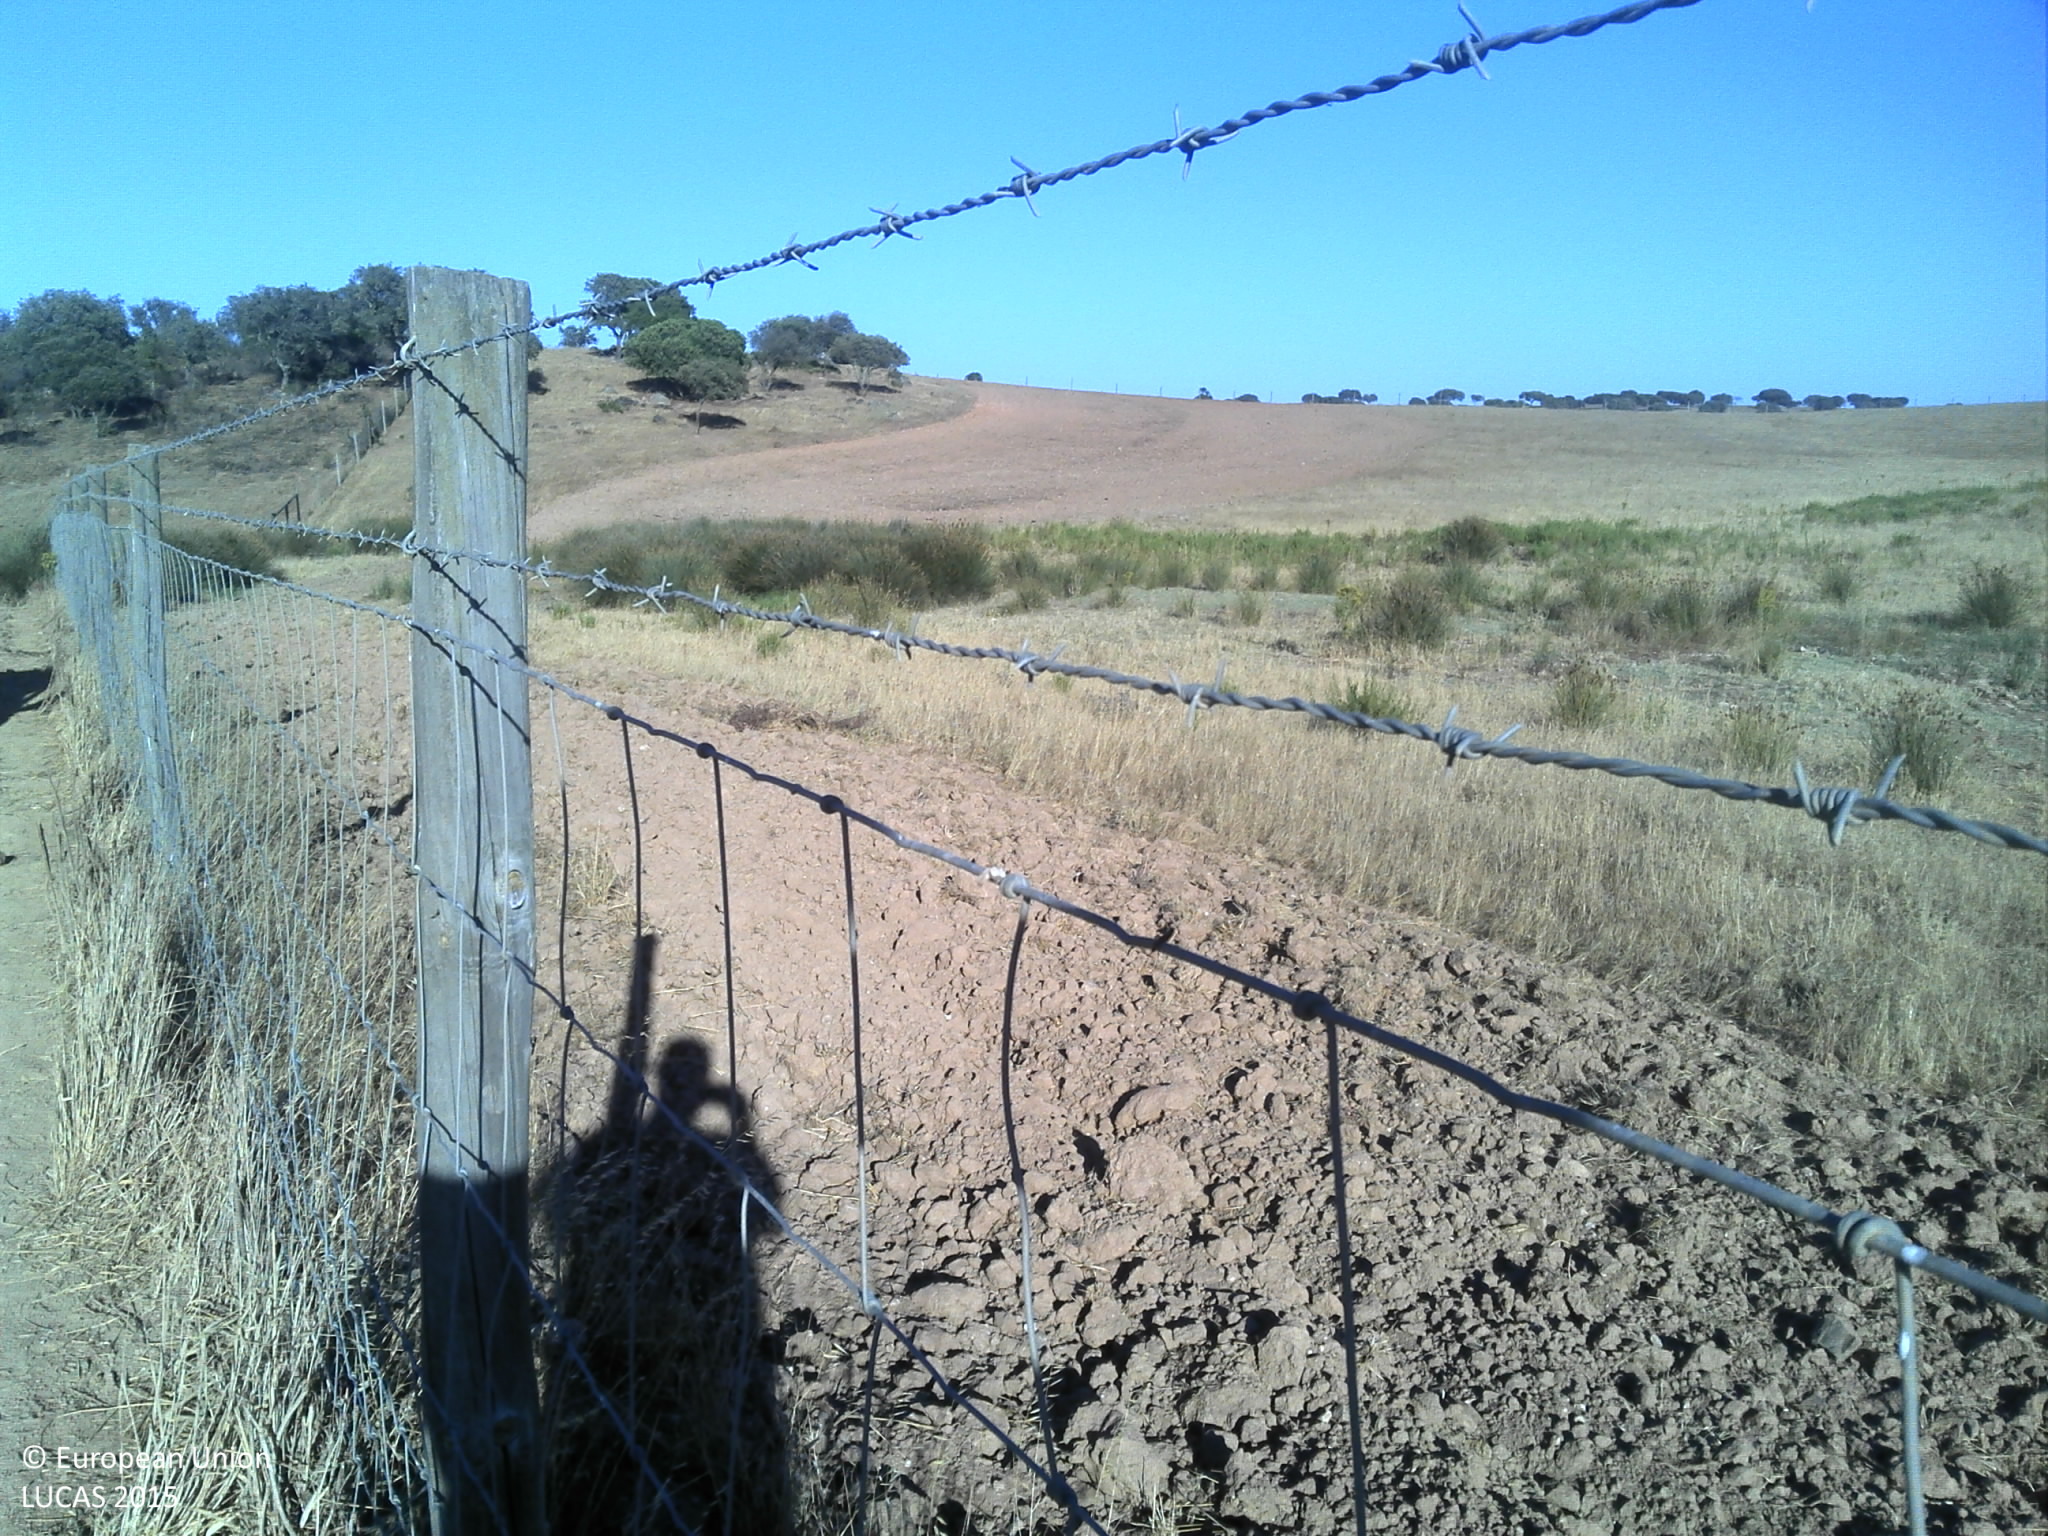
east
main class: Grassland
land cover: Grassland without tree/shrub cover
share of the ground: > 75 %
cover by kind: herbaceous plants 95 %, unconsolidated bare surface 5 %
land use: Agriculture (excluding fallow land and kitchen gardens)
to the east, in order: Grassland without tree/shrub cover; Other bare soil; Fences; Other bare soil; Grassland without tree/shrub cover; Other bare soil; Fences; Other bare soil; Grassland without tree/shrub cover; Other bare soil; Fences; Shrubland without tree cover
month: July
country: PT
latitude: 37.8792
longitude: -8.0264
